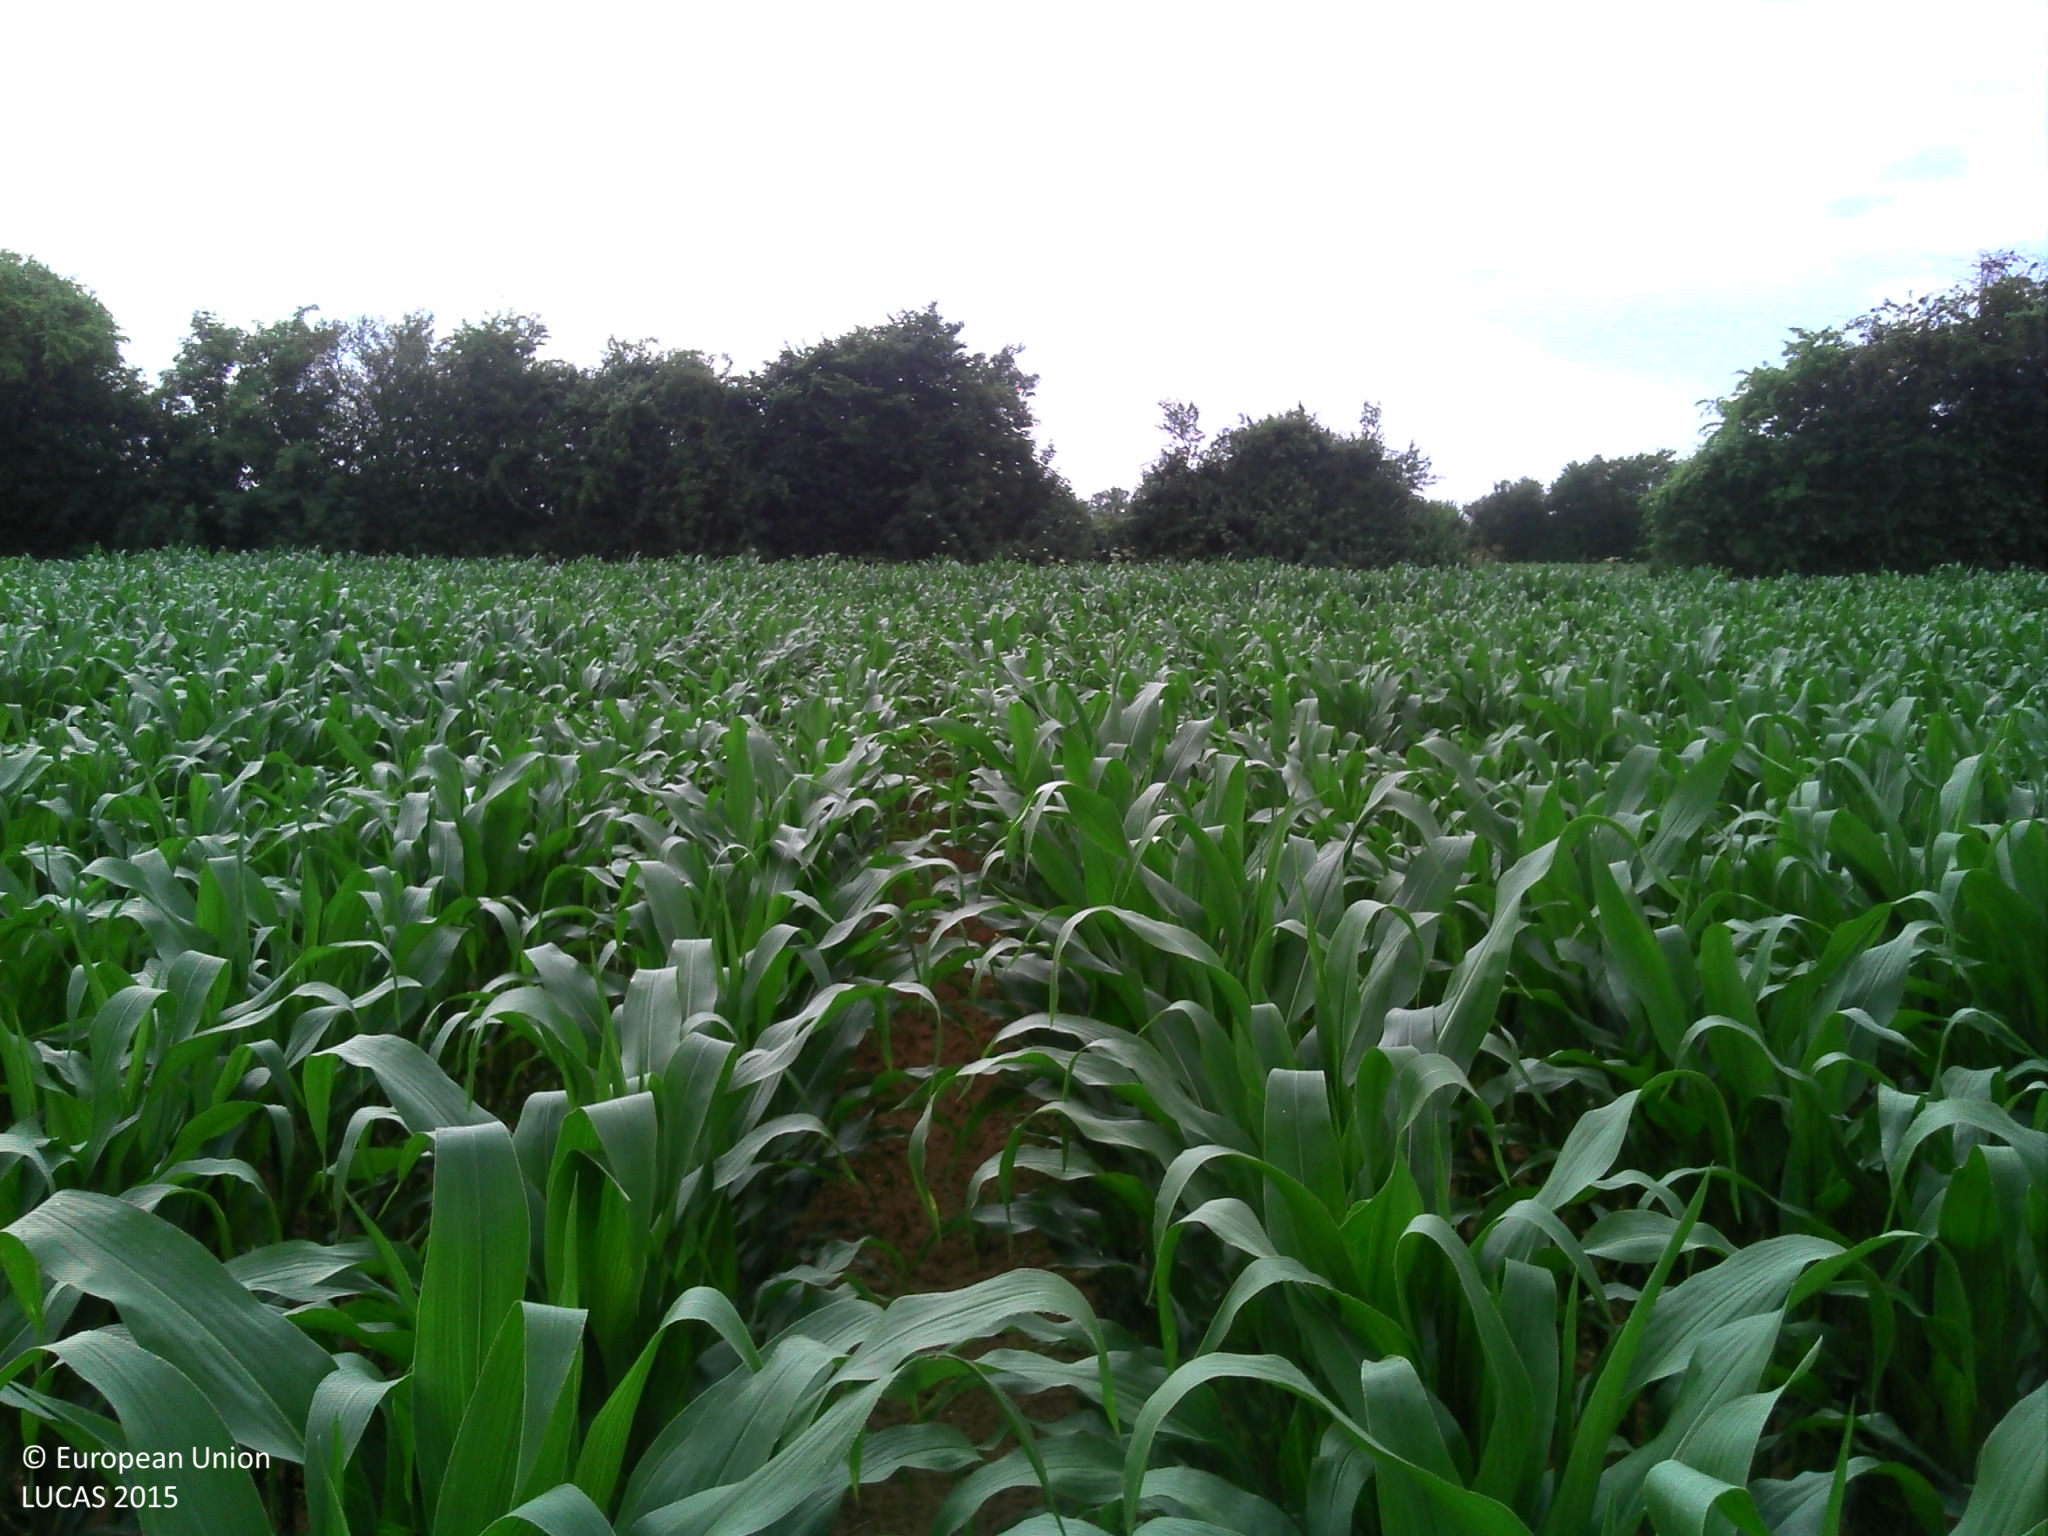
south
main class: Cropland
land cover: Maize
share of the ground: > 75 %
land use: Agriculture (excluding fallow land and kitchen gardens)
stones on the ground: < 10 %
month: July
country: FR
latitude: 48.9653
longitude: 0.0118
